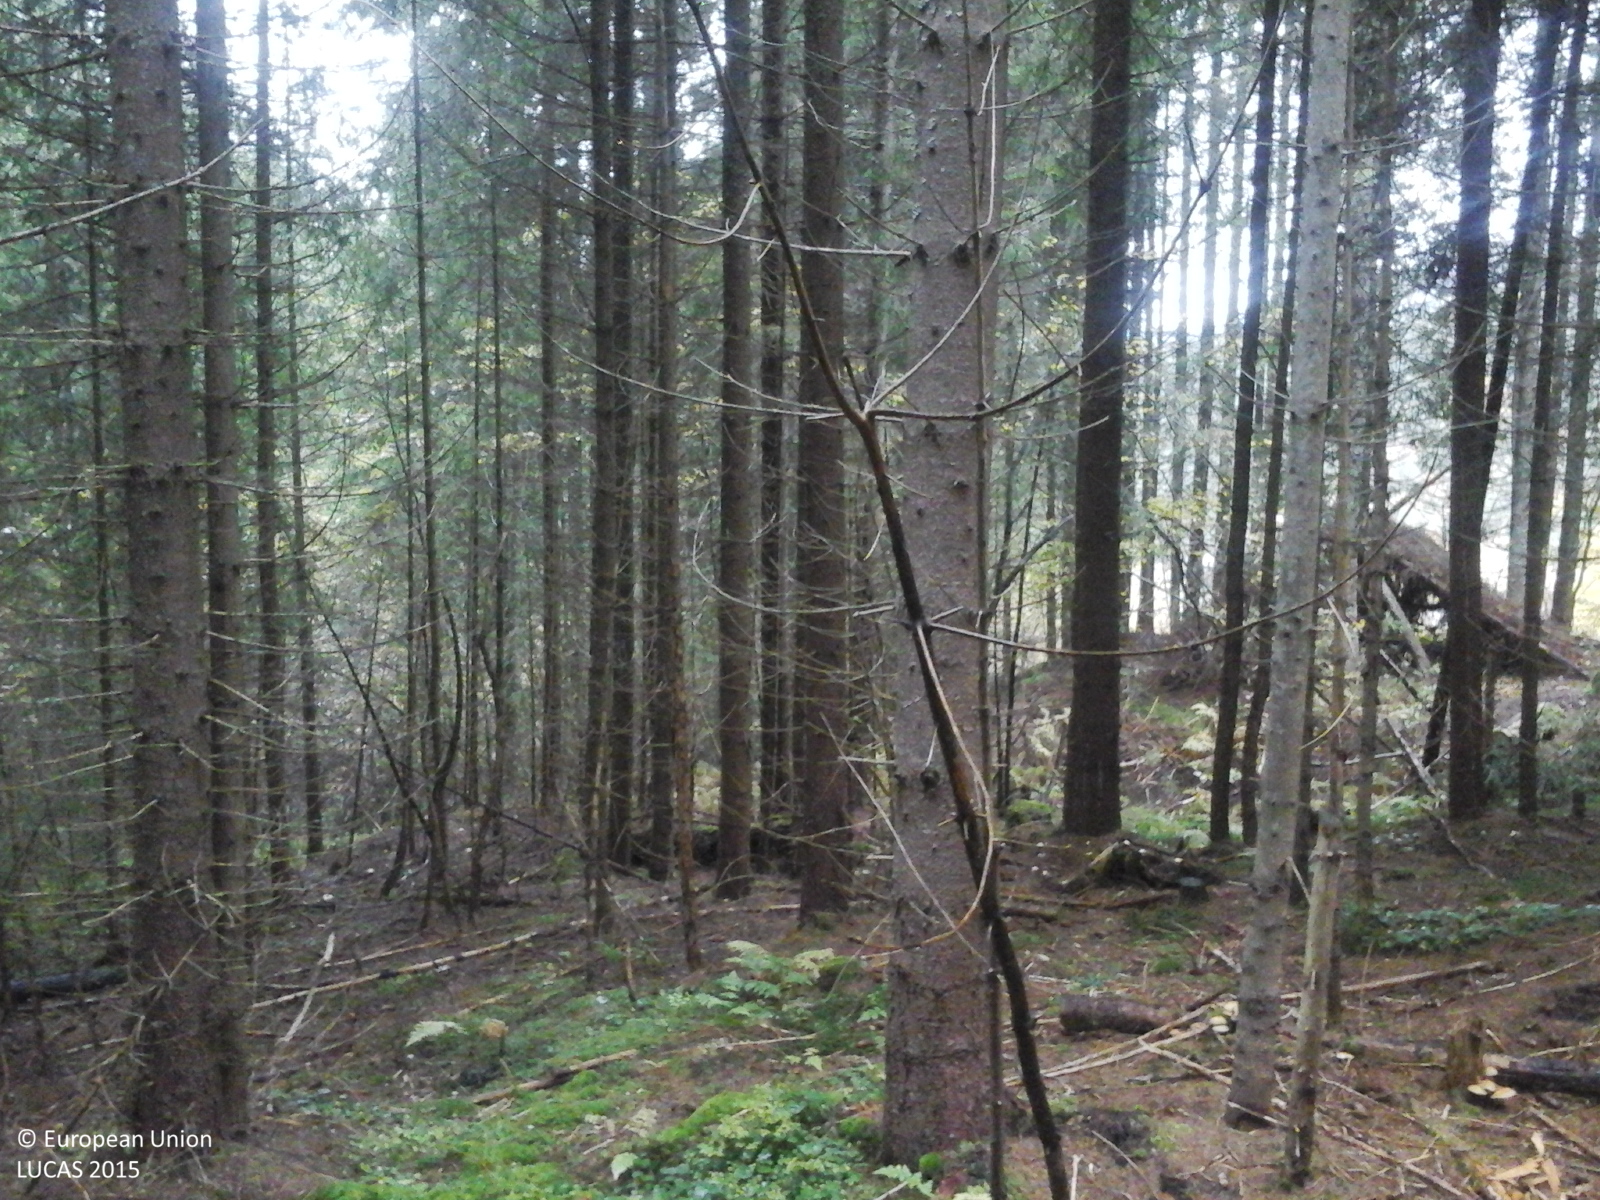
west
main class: Woodland
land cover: Spruce dominated coniferous woodland
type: alpine coniferous forest
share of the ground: > 75 %
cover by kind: coniferous forest trees 100 %
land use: Forestry
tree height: > 5 m
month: October
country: RO
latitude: 46.8291
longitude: 25.2200
